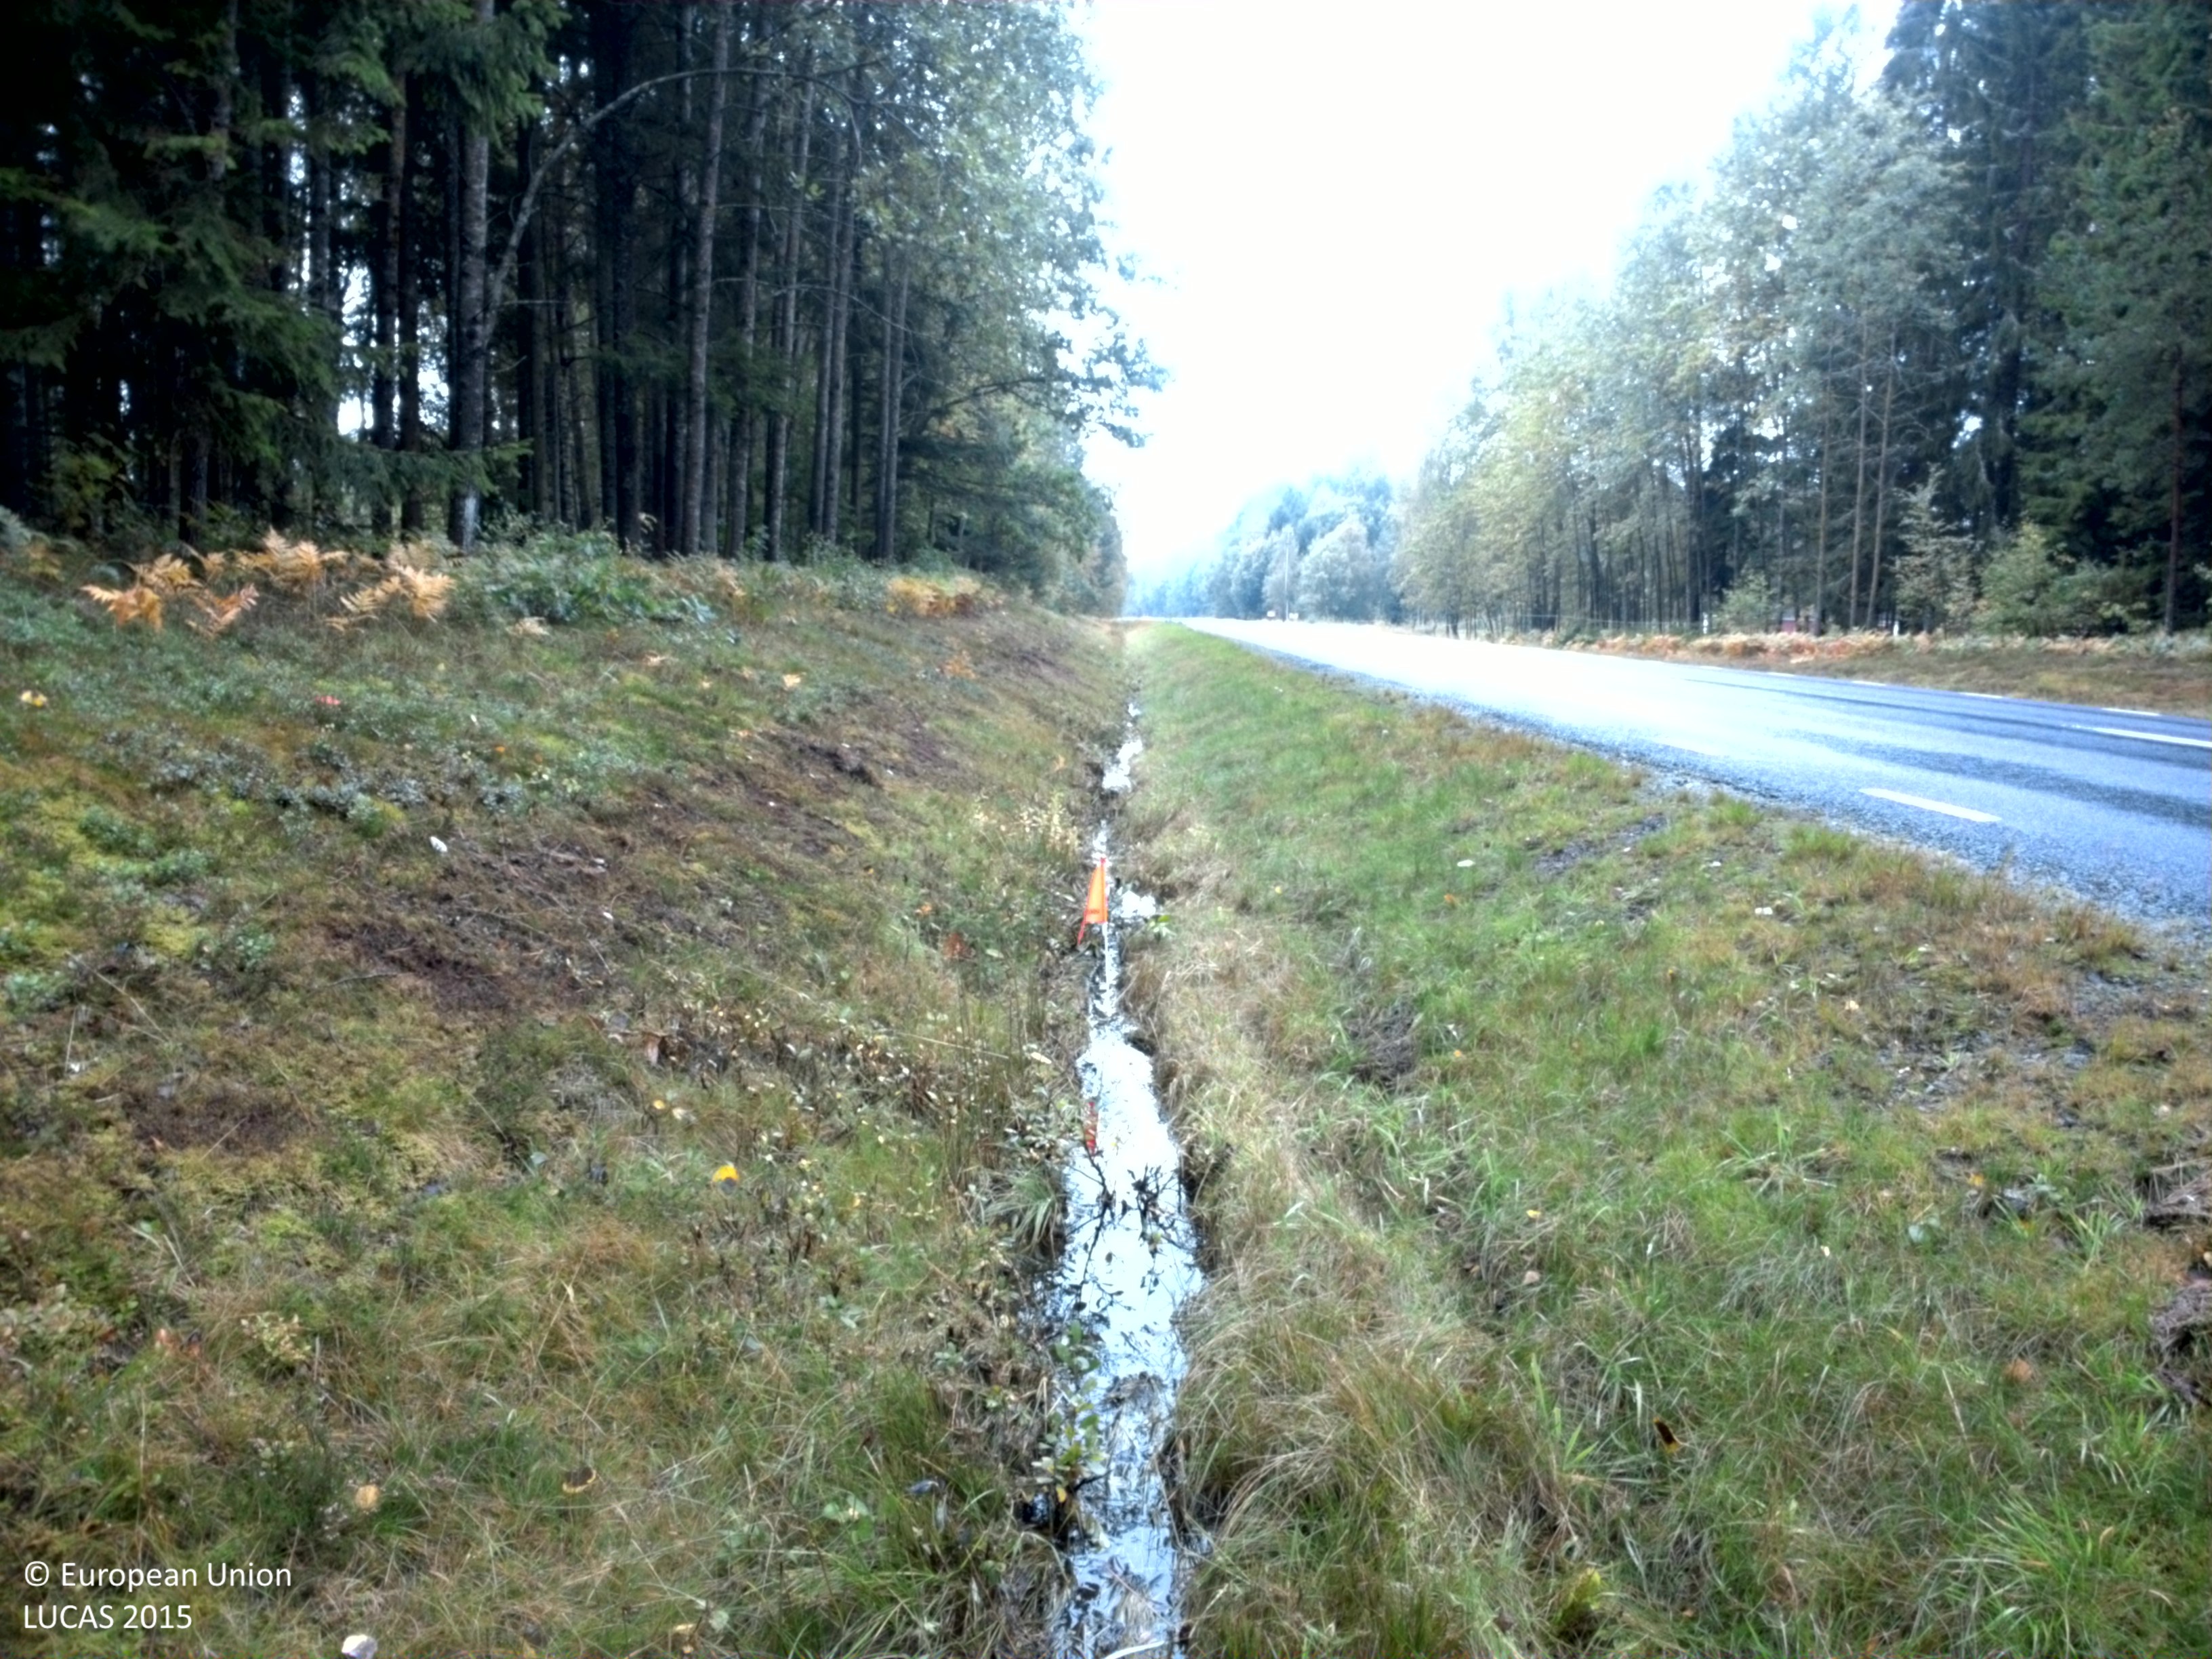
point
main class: Woodland
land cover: Spruce dominated mixed woodland
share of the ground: 50 - 75 %
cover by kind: coniferous forest trees 45 %, herbaceous plants 35 %, broadleaved forest trees 20 %
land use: Forestry
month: September
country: SE
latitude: 58.9503
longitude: 14.0774
